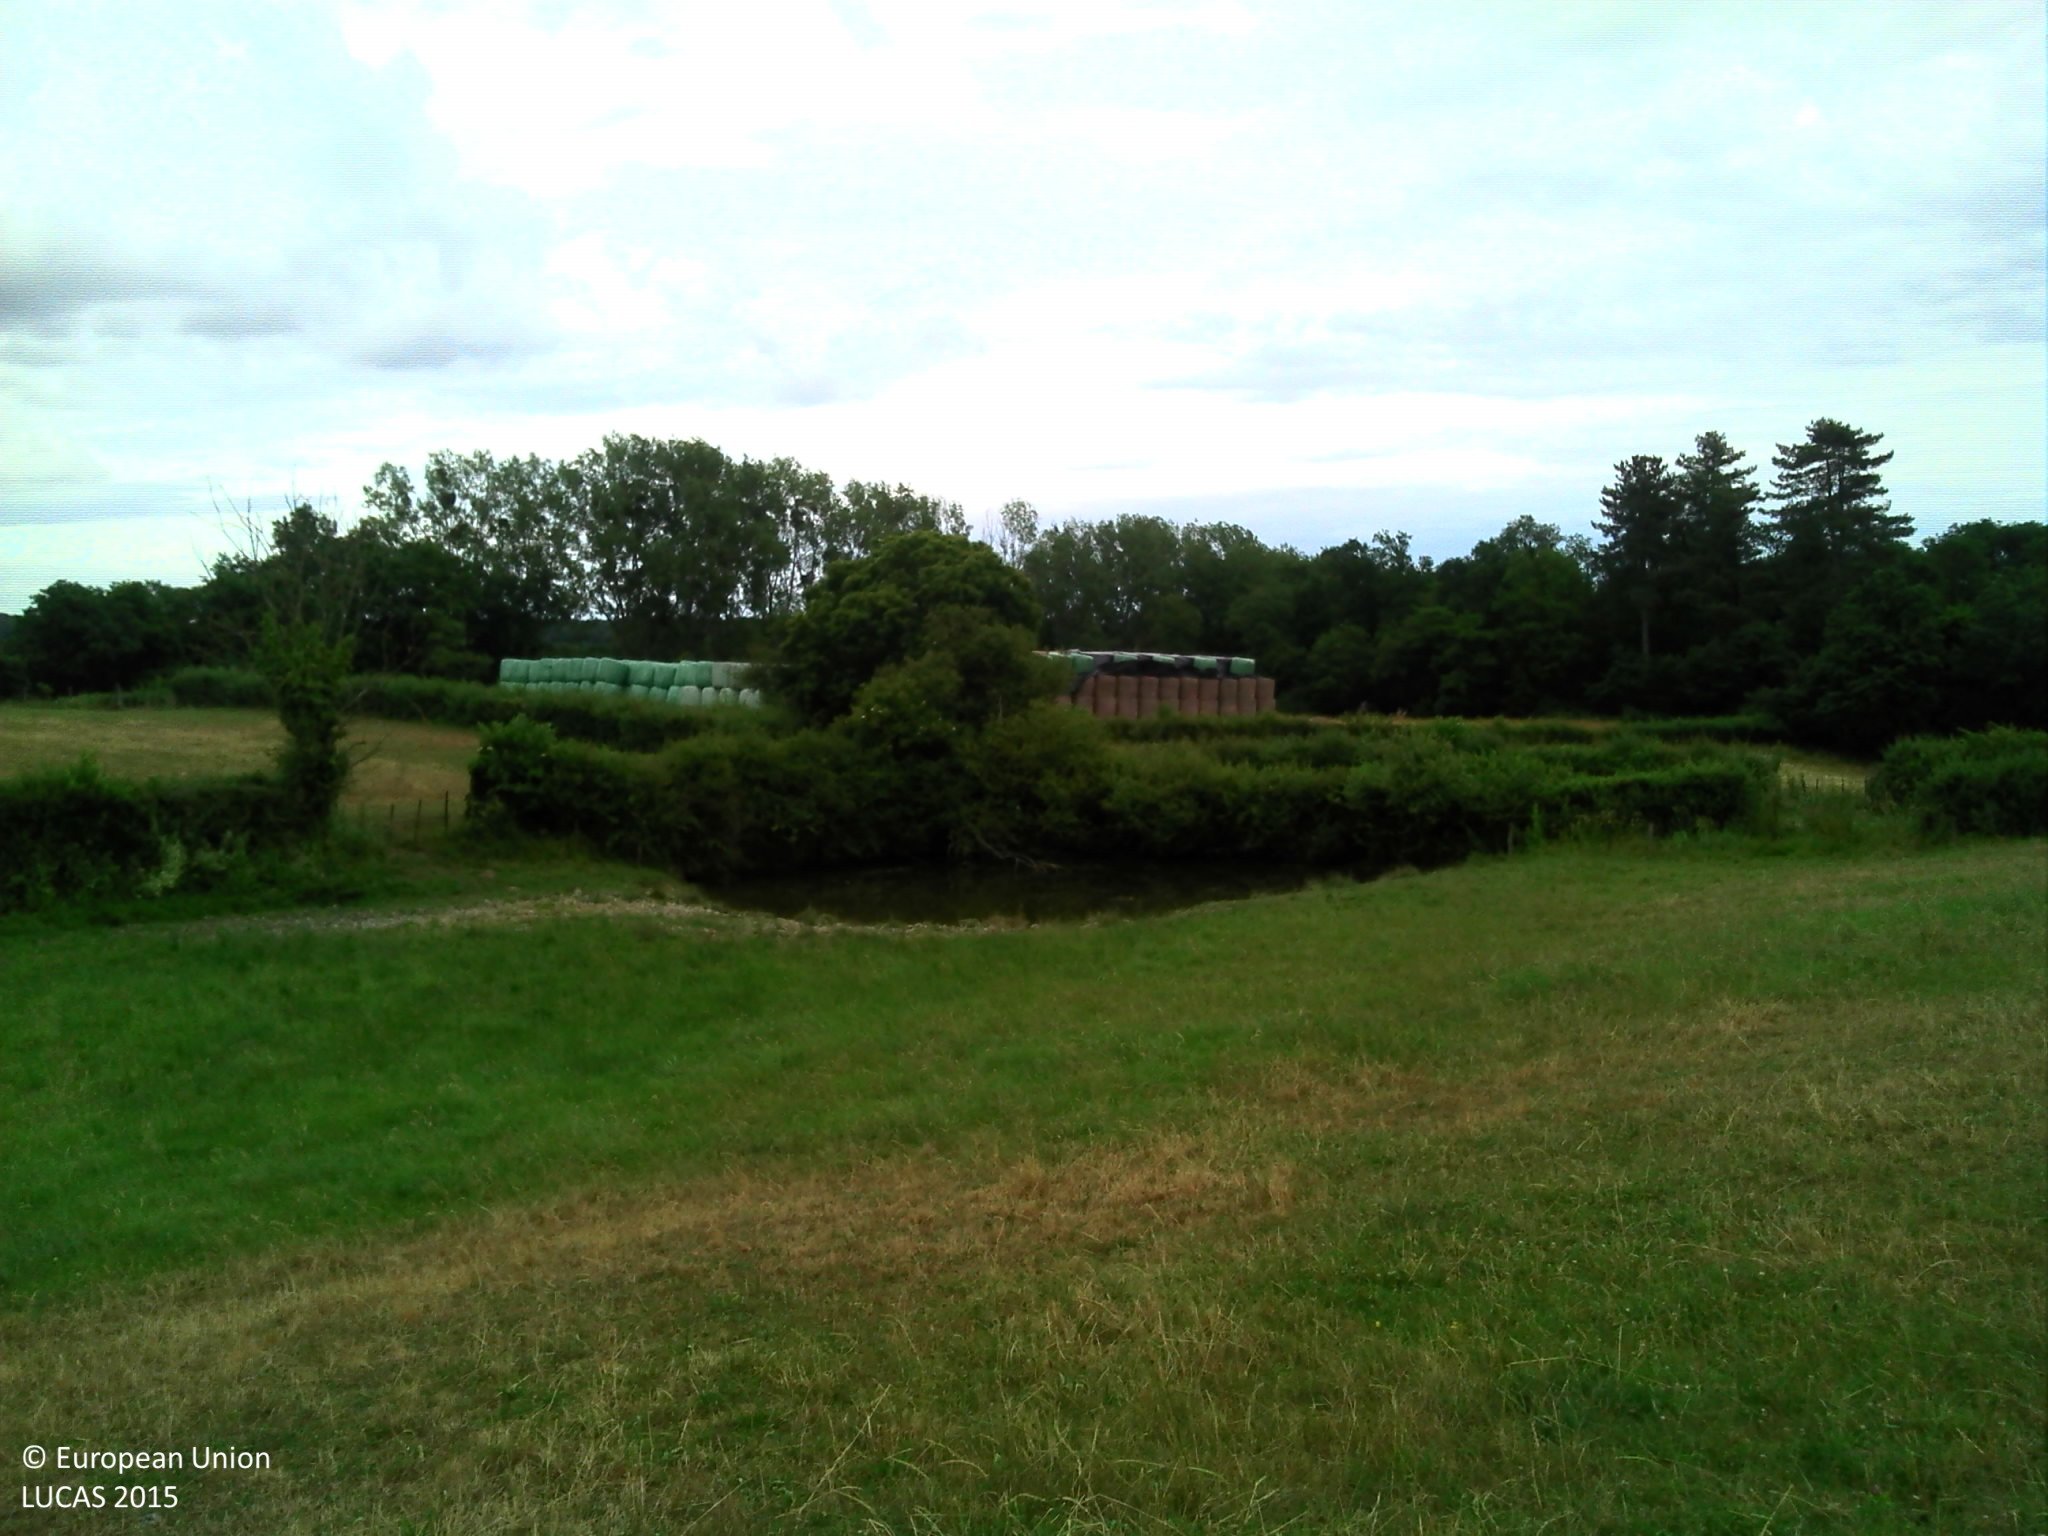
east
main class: Grassland
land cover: Grassland without tree/shrub cover
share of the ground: > 75 %
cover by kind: herbaceous plants 100 %
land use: Agriculture (excluding fallow land and kitchen gardens)
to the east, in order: Grassland without tree/shrub cover; Inland fresh water bodies; Fences; Abandoned hedges; Grass margins; Paved roads, cycling and walking lanes; Grass margins; Managed hedges; Fences; Grassland without tree/shrub cover; Managed hedges; Fences; Spontaneously vegetated surfaces; Maize; Shrubland with sparse tree cover; Broadleaved woodland; Inland fresh running water; Broadleaved woodland; Fences; Grassland without tree/shrub cover
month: June
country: FR
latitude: 46.5199
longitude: 2.7355
